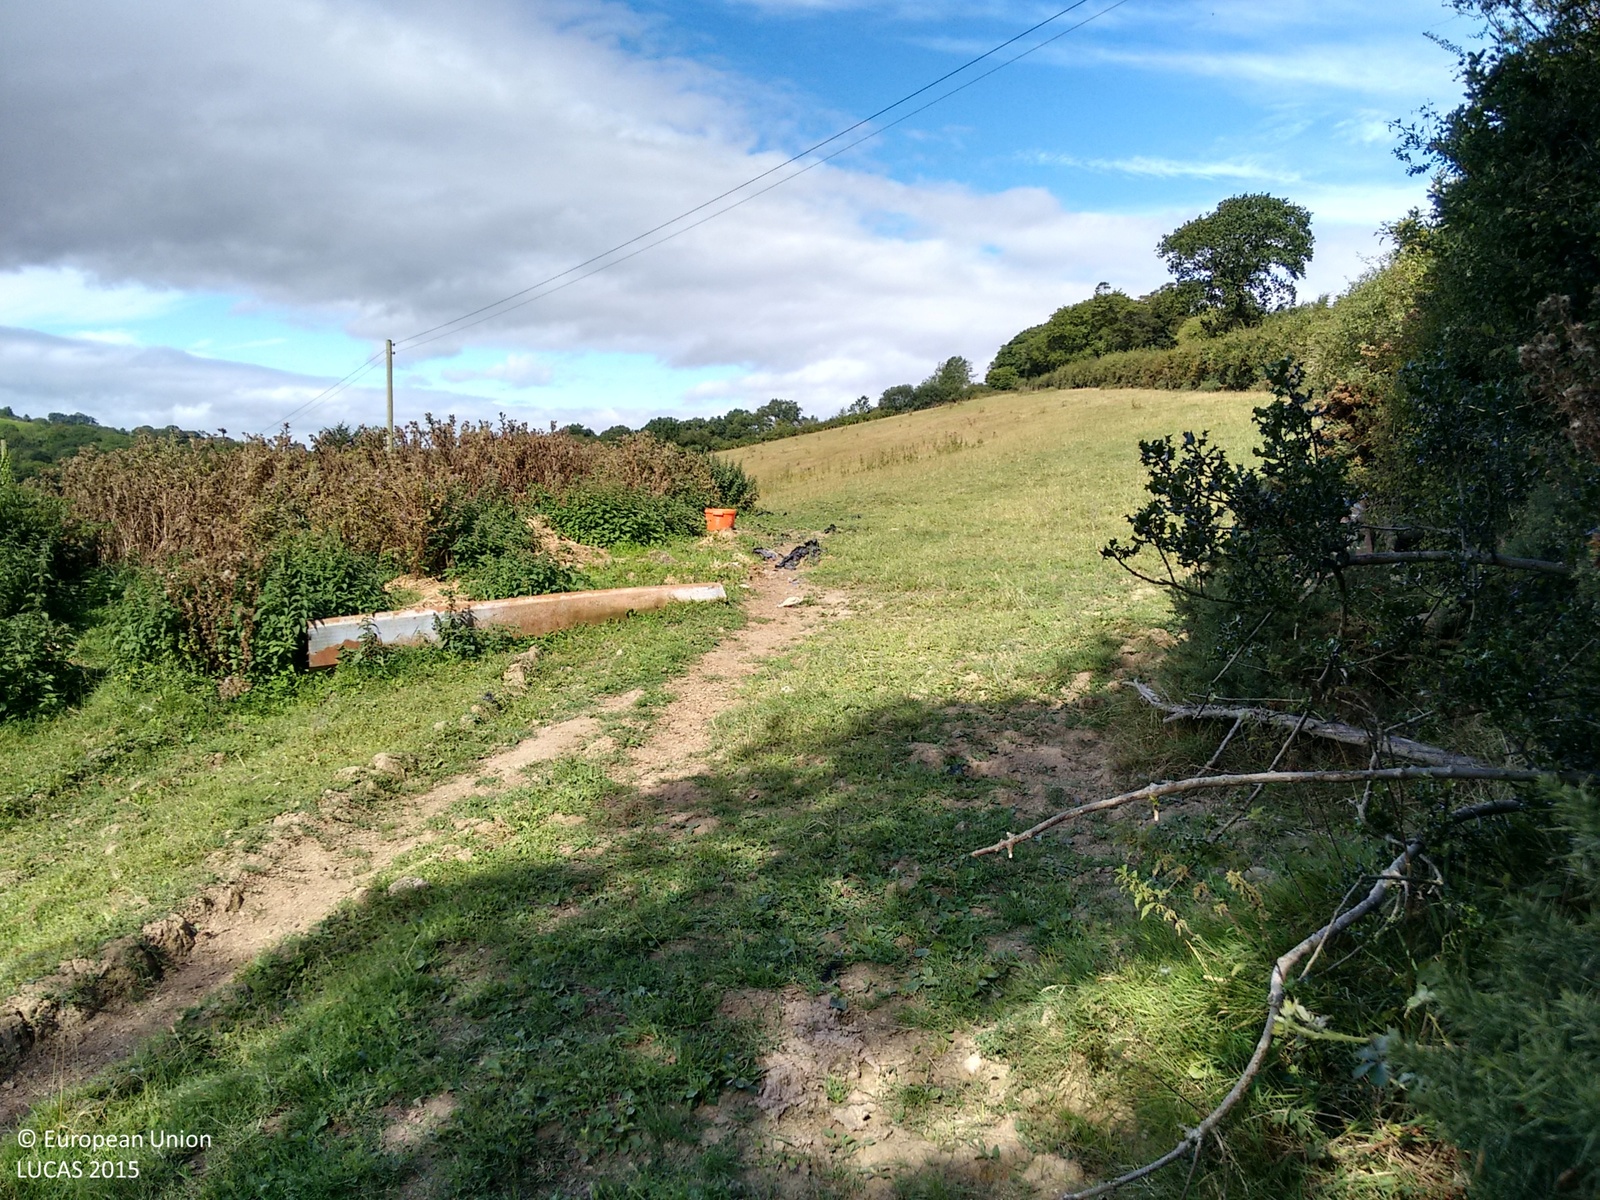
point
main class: Grassland
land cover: Grassland without tree/shrub cover
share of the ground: > 75 %
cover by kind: herbaceous plants 100 %
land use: Agriculture (excluding fallow land and kitchen gardens)
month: August
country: GB
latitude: 50.7339
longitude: -3.5884
